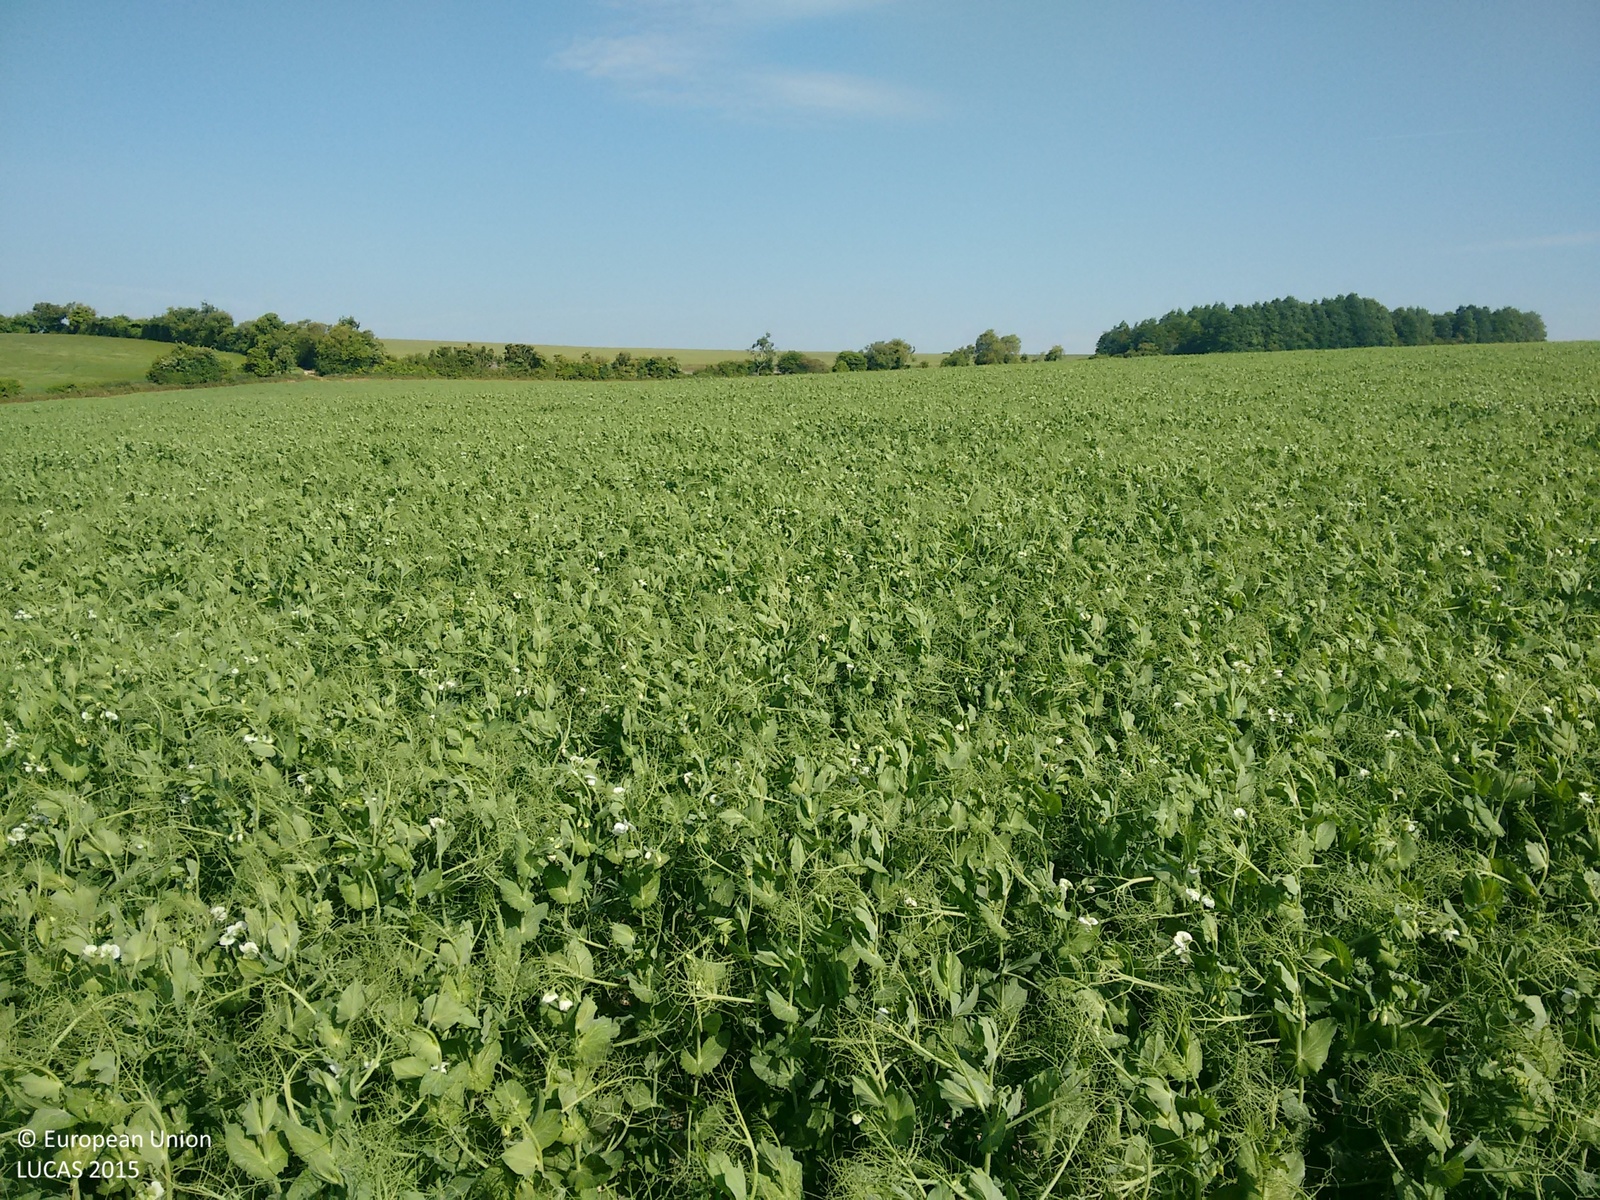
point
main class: Cropland
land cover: Dry pulses
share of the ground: > 75 %
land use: Agriculture (excluding fallow land and kitchen gardens)
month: June
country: GB
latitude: 51.1247
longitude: -1.8728
